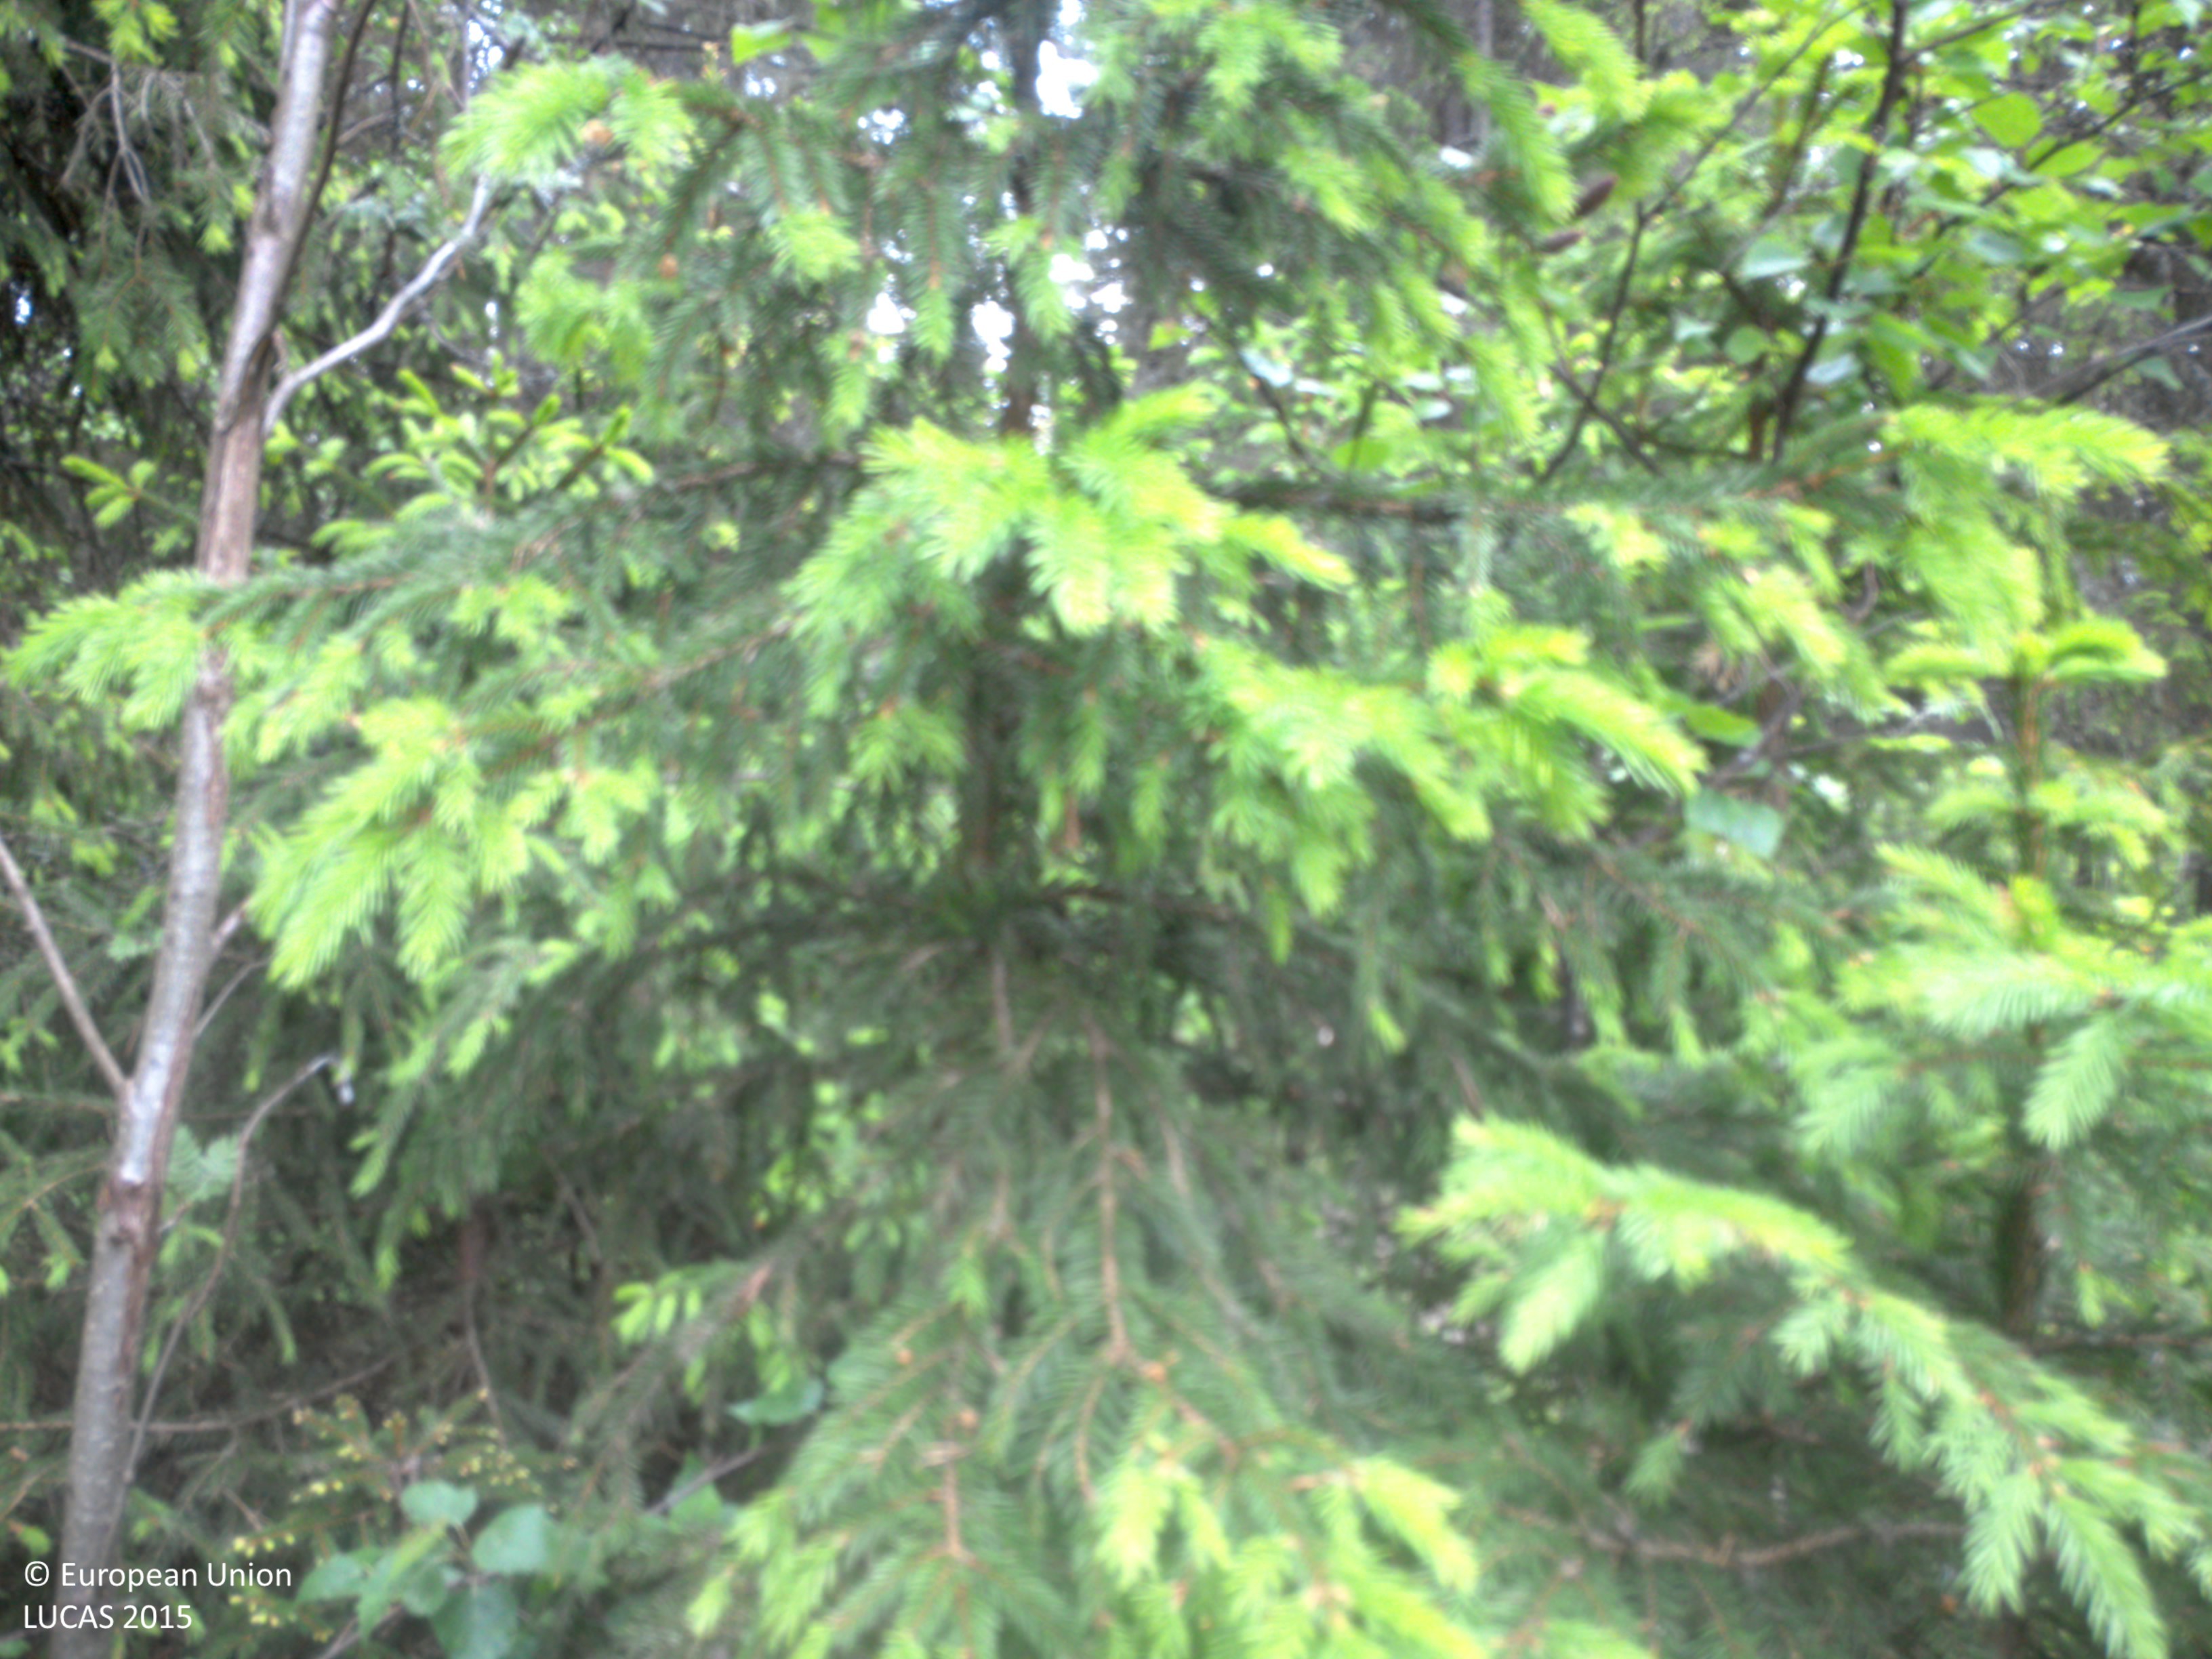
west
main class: Woodland
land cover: Spruce dominated coniferous woodland
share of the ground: 25 - 50 %
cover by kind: coniferous forest trees 50 %, consolidated bare surface 40 %, herbaceous plants 10 %
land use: Residential
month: June
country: SE
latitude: 63.5977
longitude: 19.8783
